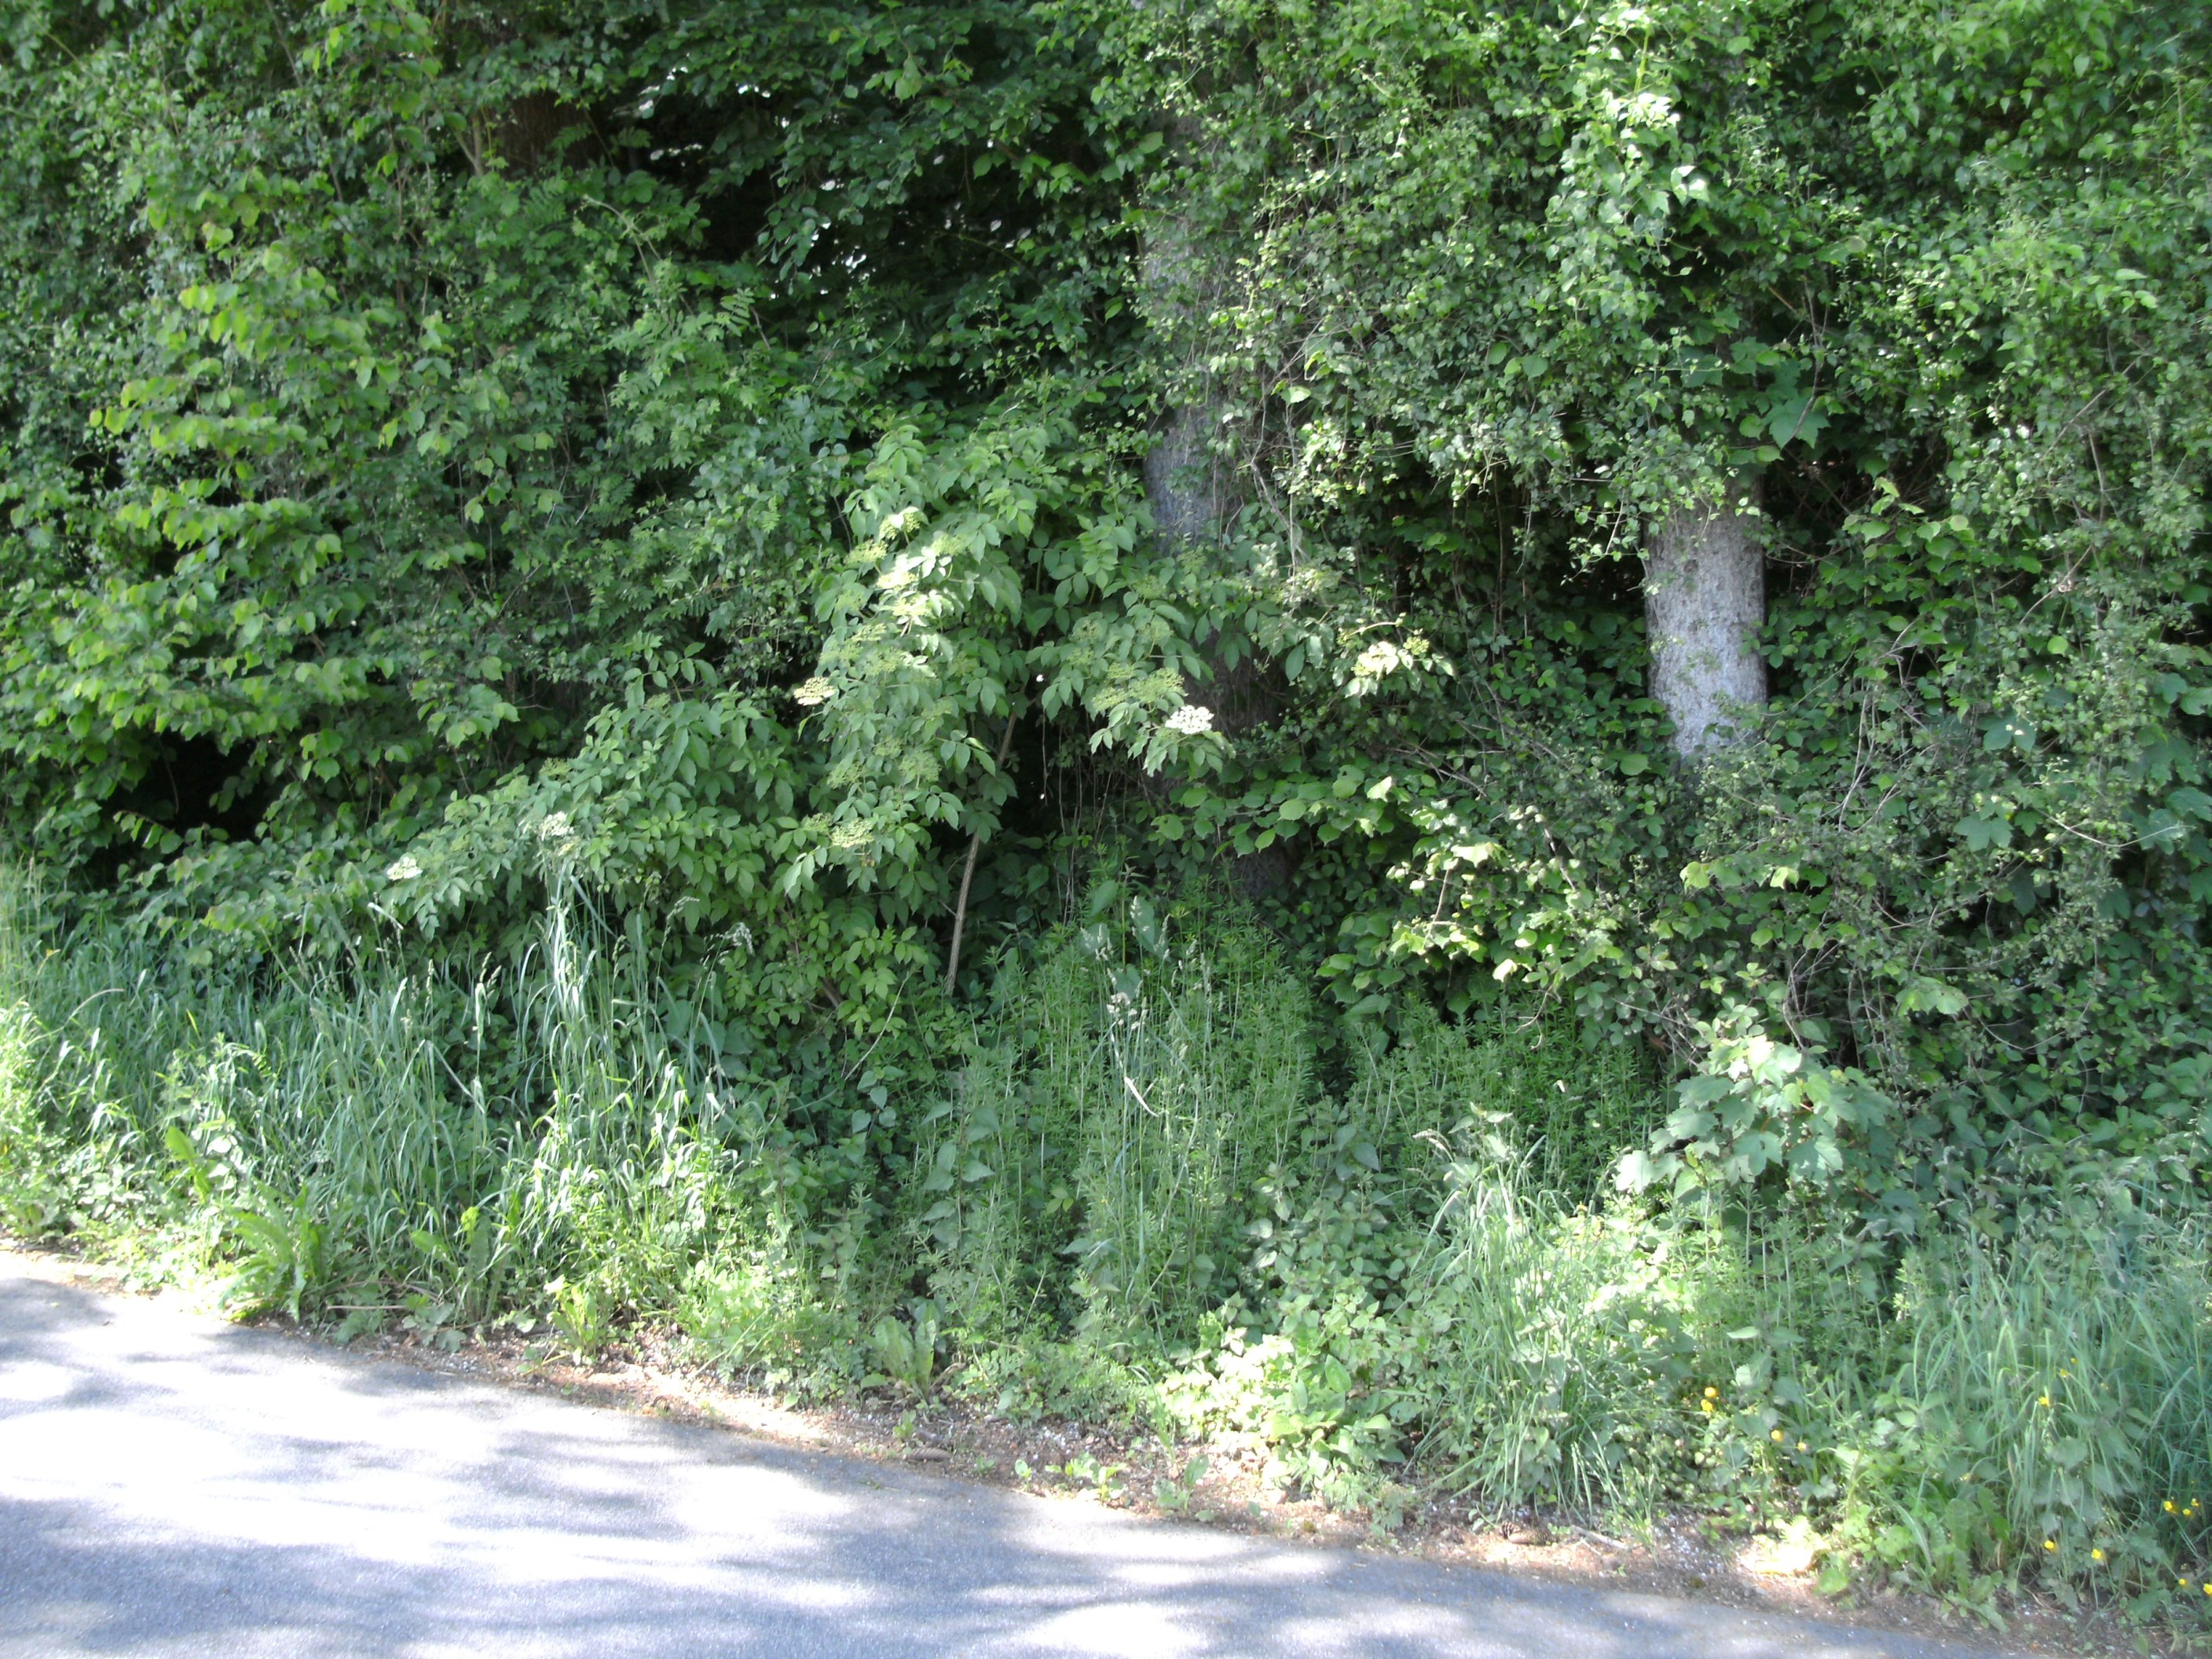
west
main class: Grassland
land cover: Grassland without tree/shrub cover
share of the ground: > 75 %
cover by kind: herbaceous plants 100 %
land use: Agriculture (excluding fallow land and kitchen gardens)
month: May
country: AT
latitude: 48.0240
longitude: 13.4987
